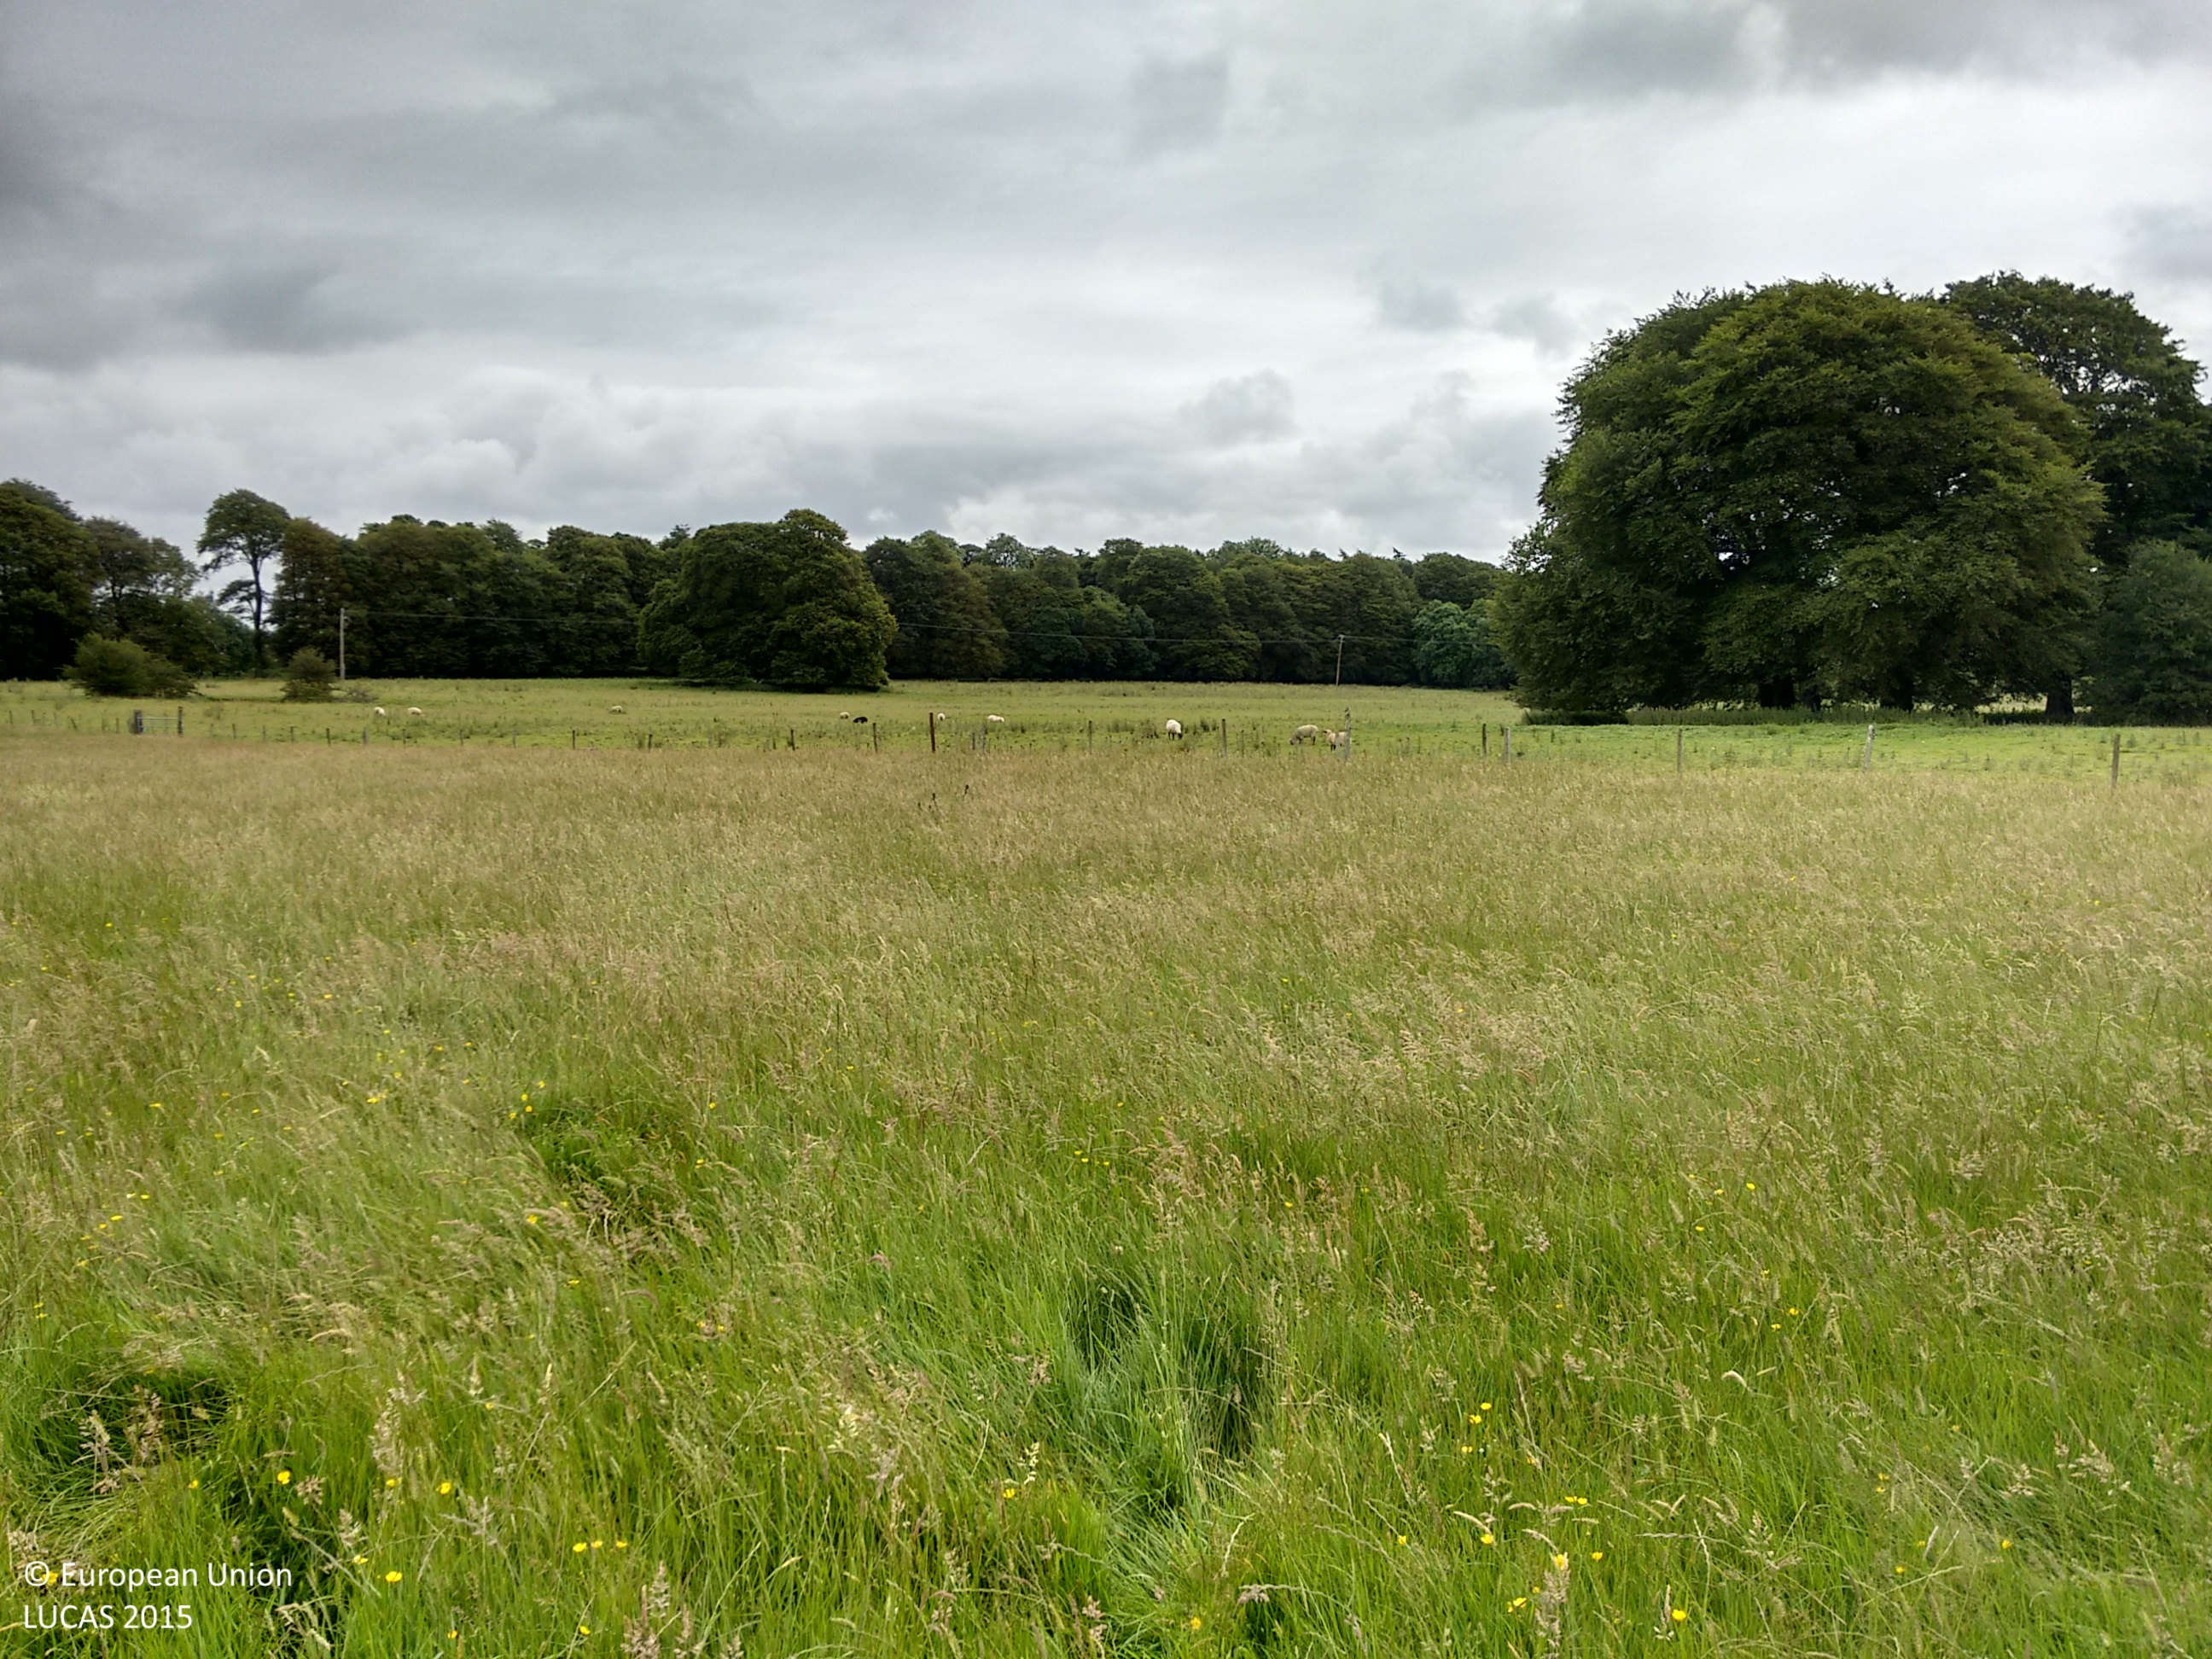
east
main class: Grassland
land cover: Grassland without tree/shrub cover
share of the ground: > 75 %
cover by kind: herbaceous plants 100 %
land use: Agriculture (excluding fallow land and kitchen gardens)
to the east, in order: Grassland without tree/shrub cover; Fences; Grassland without tree/shrub cover; Broadleaved woodland; Grassland without tree/shrub cover
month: July
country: IE
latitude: 53.6185
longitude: -8.1554
